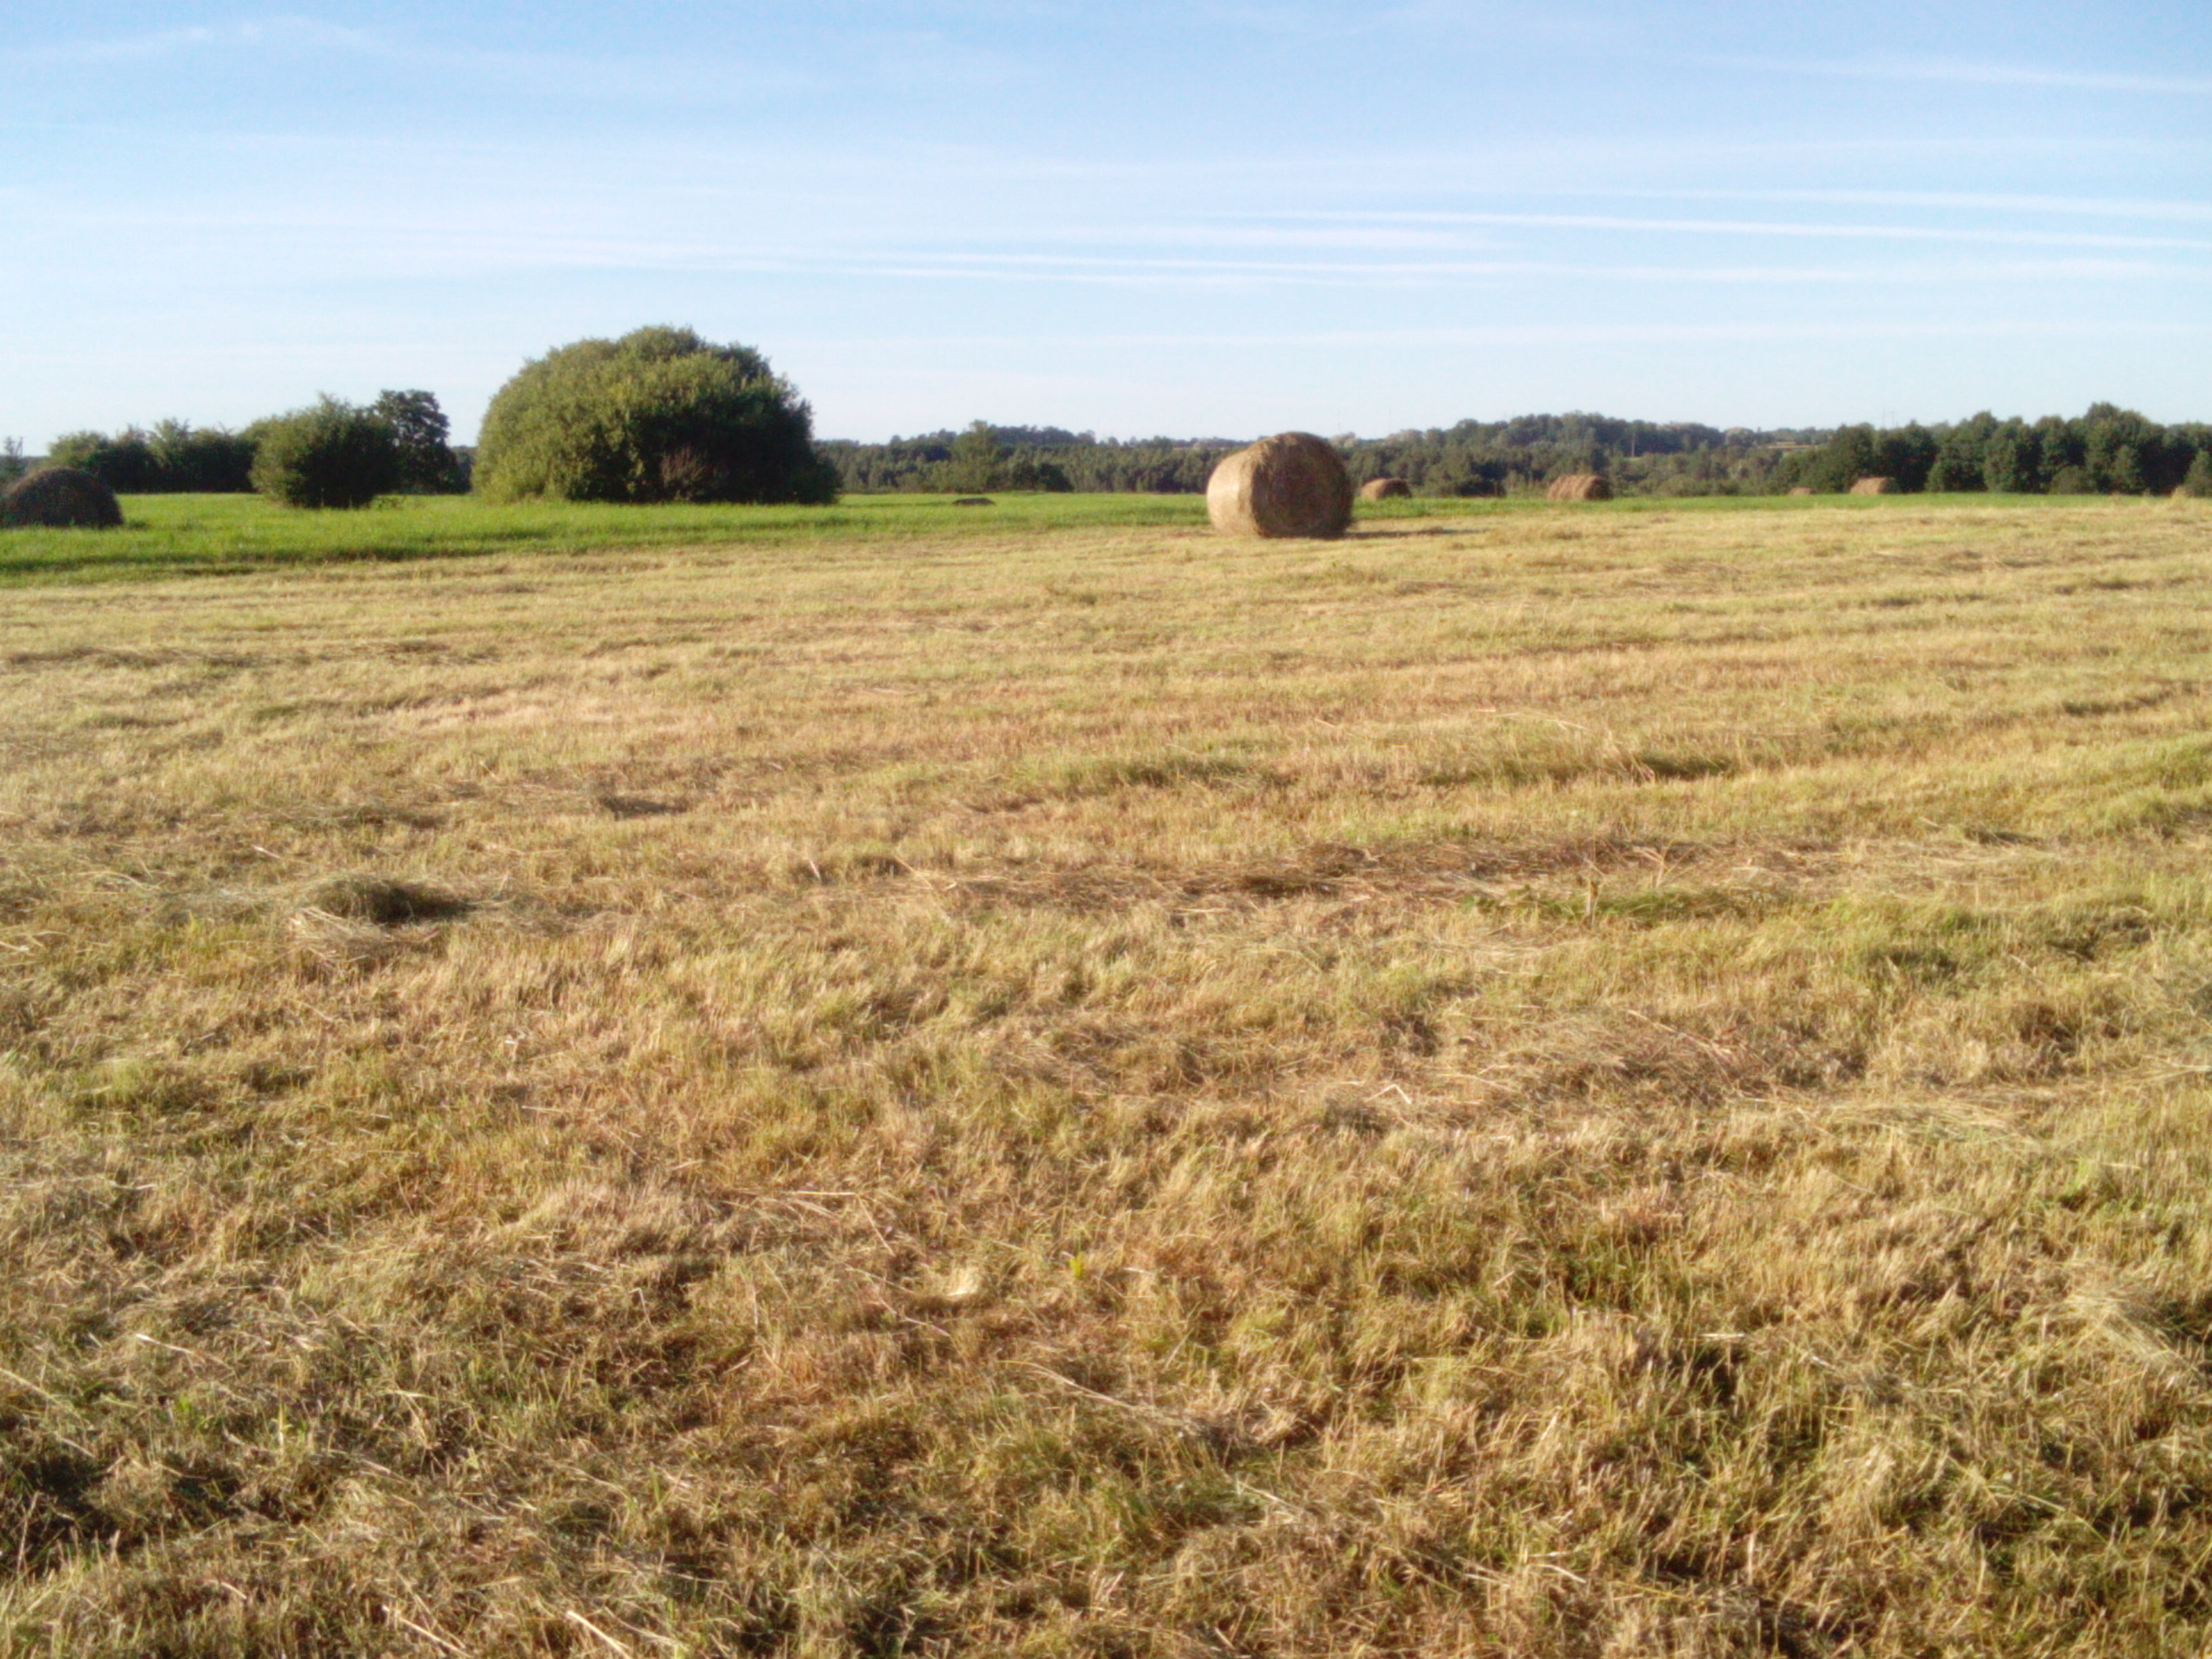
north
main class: Grassland
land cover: Grassland without tree/shrub cover
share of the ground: > 75 %
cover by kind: herbaceous plants 100 %
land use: Agriculture (excluding fallow land and kitchen gardens)
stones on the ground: < 10 %
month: August
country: LV
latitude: 56.5523
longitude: 21.3790
